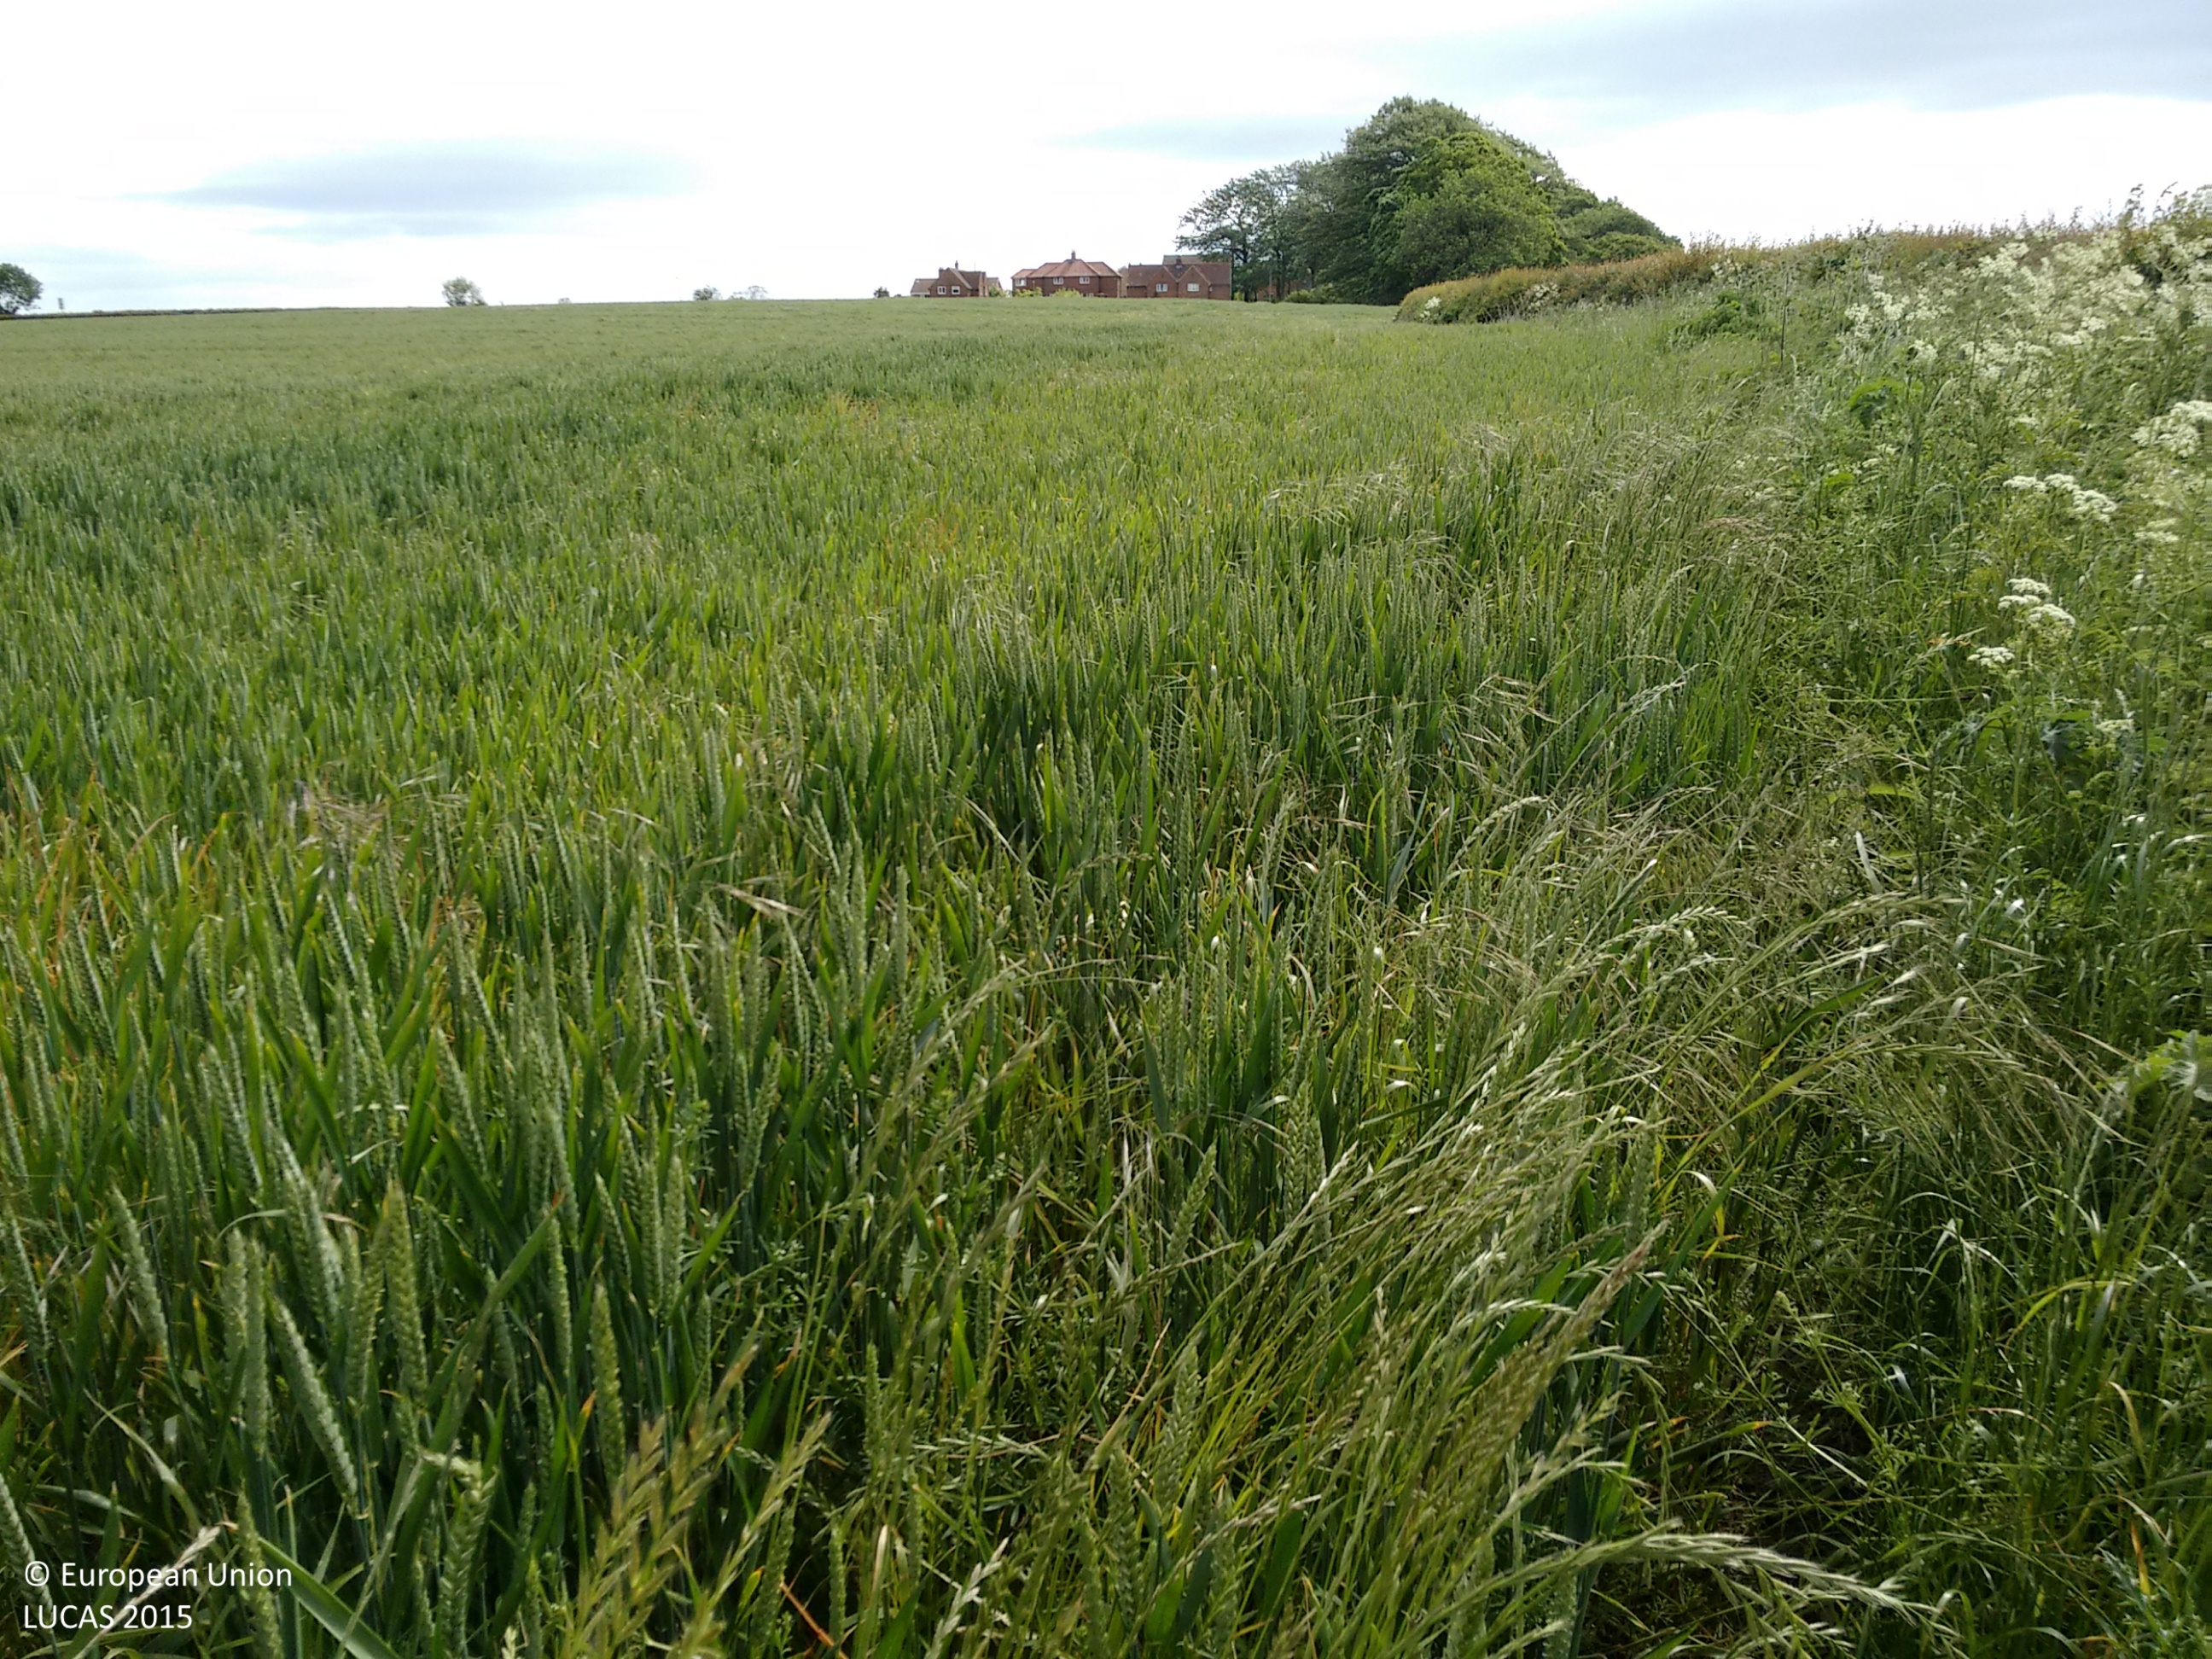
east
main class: Cropland
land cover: Common wheat
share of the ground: > 75 %
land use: Agriculture (excluding fallow land and kitchen gardens)
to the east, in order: Common wheat; Grass margins; Managed hedges; Grass margins; Paved roads, cycling and walking lanes; Artificial constructions in urban areas
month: June
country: GB
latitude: 54.4354
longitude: -1.4722
